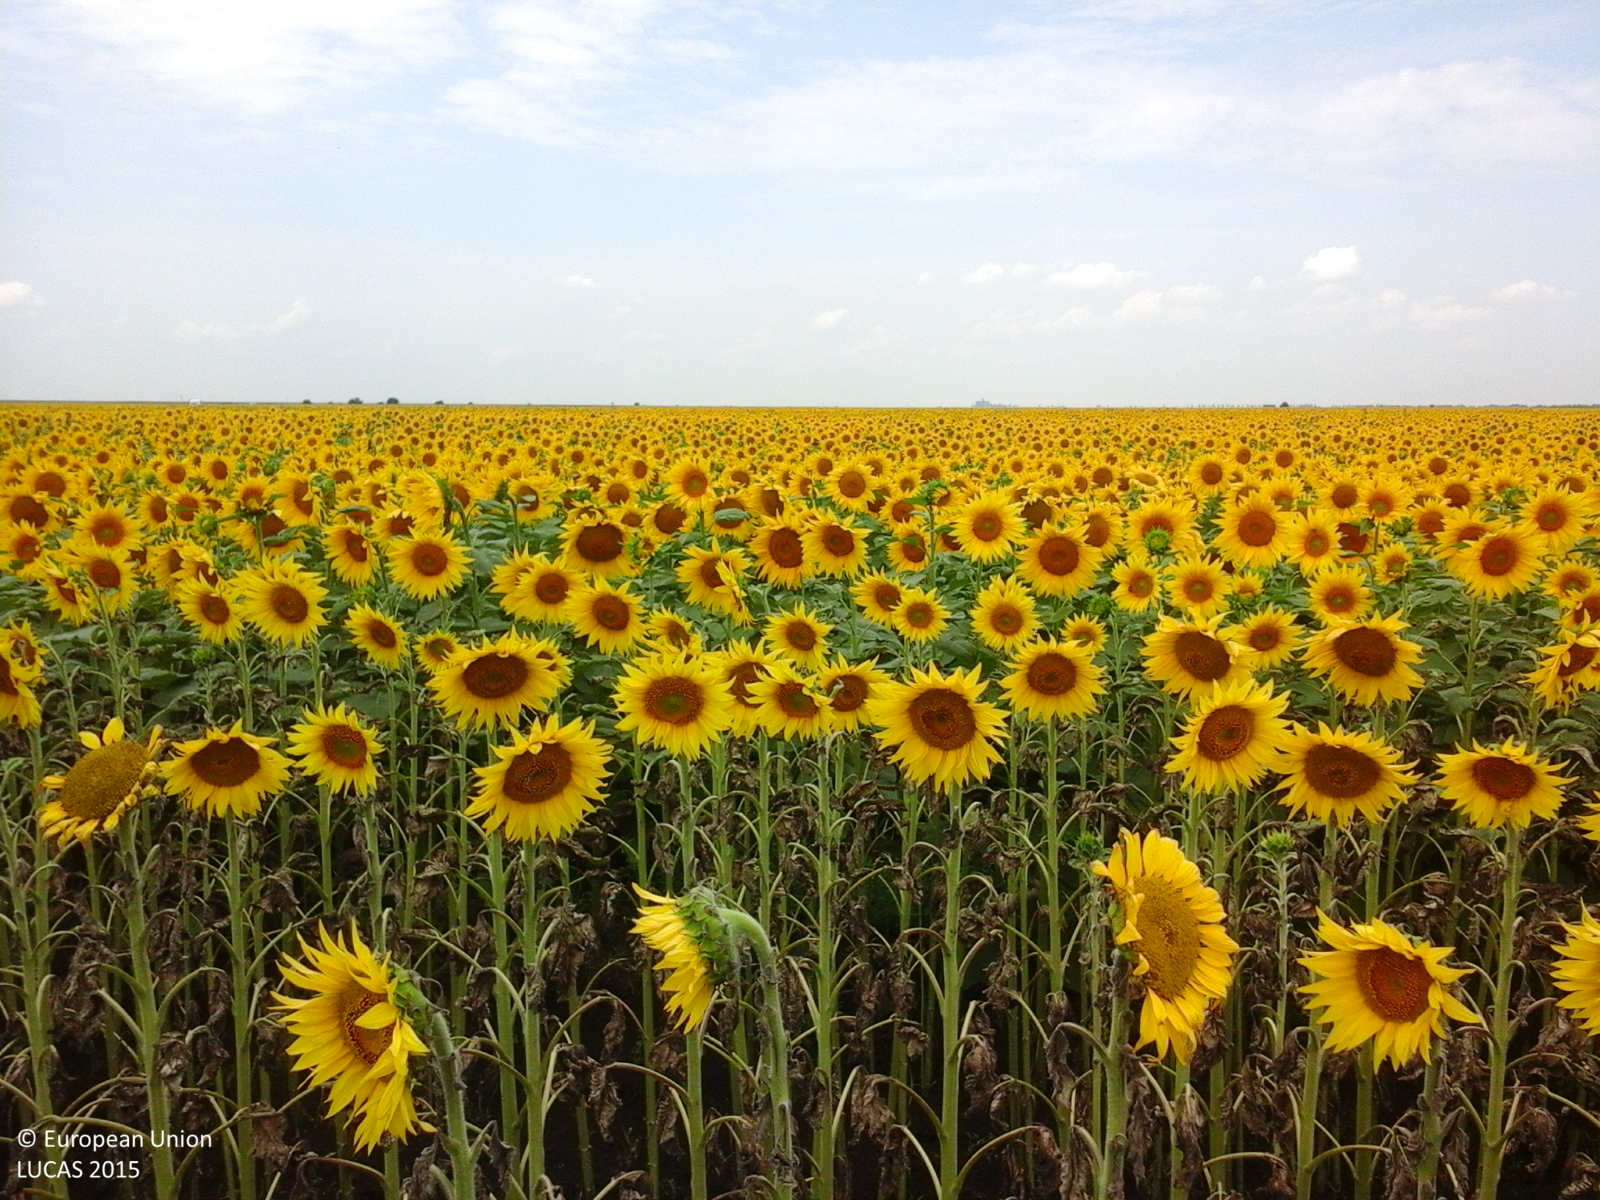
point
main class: Cropland
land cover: Sunflower
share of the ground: > 75 %
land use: Agriculture (excluding fallow land and kitchen gardens)
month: July
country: RO
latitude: 44.0007
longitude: 25.8710
